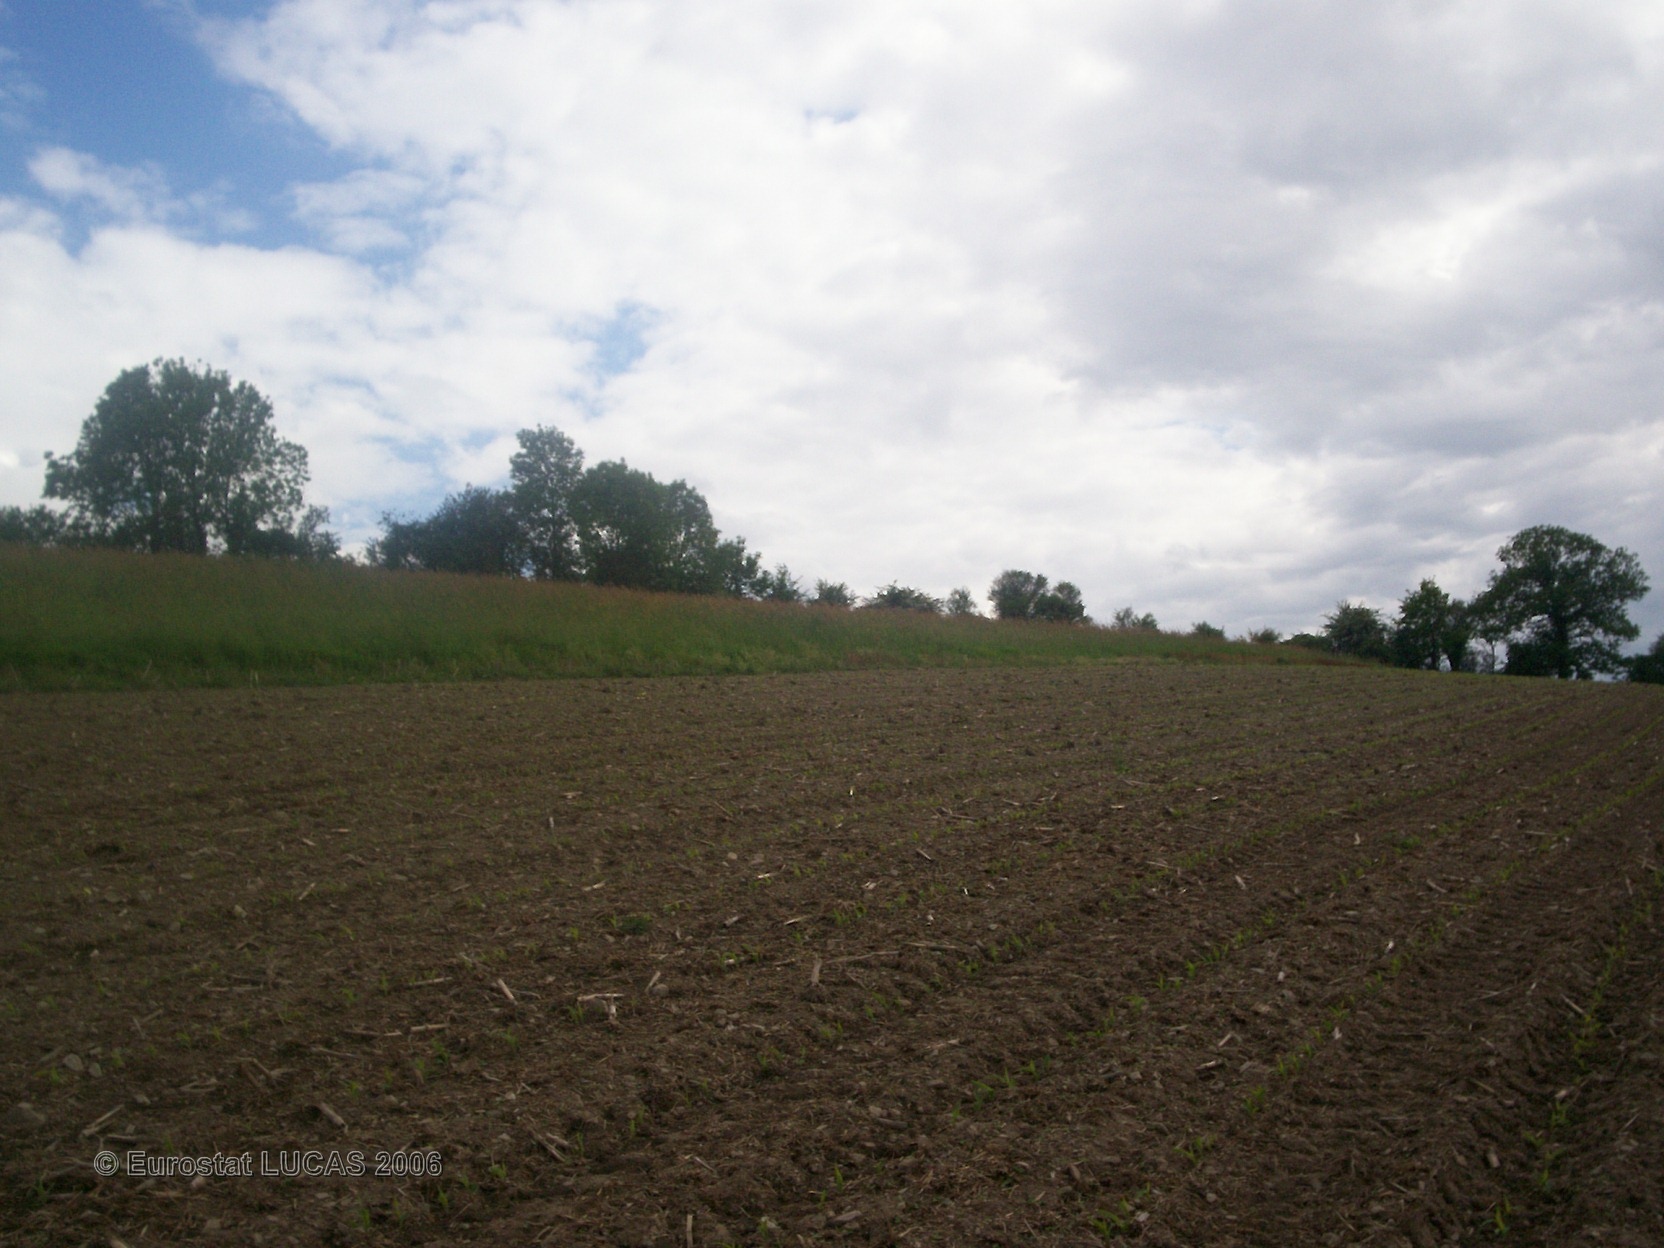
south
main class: Cropland
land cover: Maize
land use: Agriculture (excluding fallow land and kitchen gardens)
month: May
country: FR
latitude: 48.1808
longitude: -0.2392
